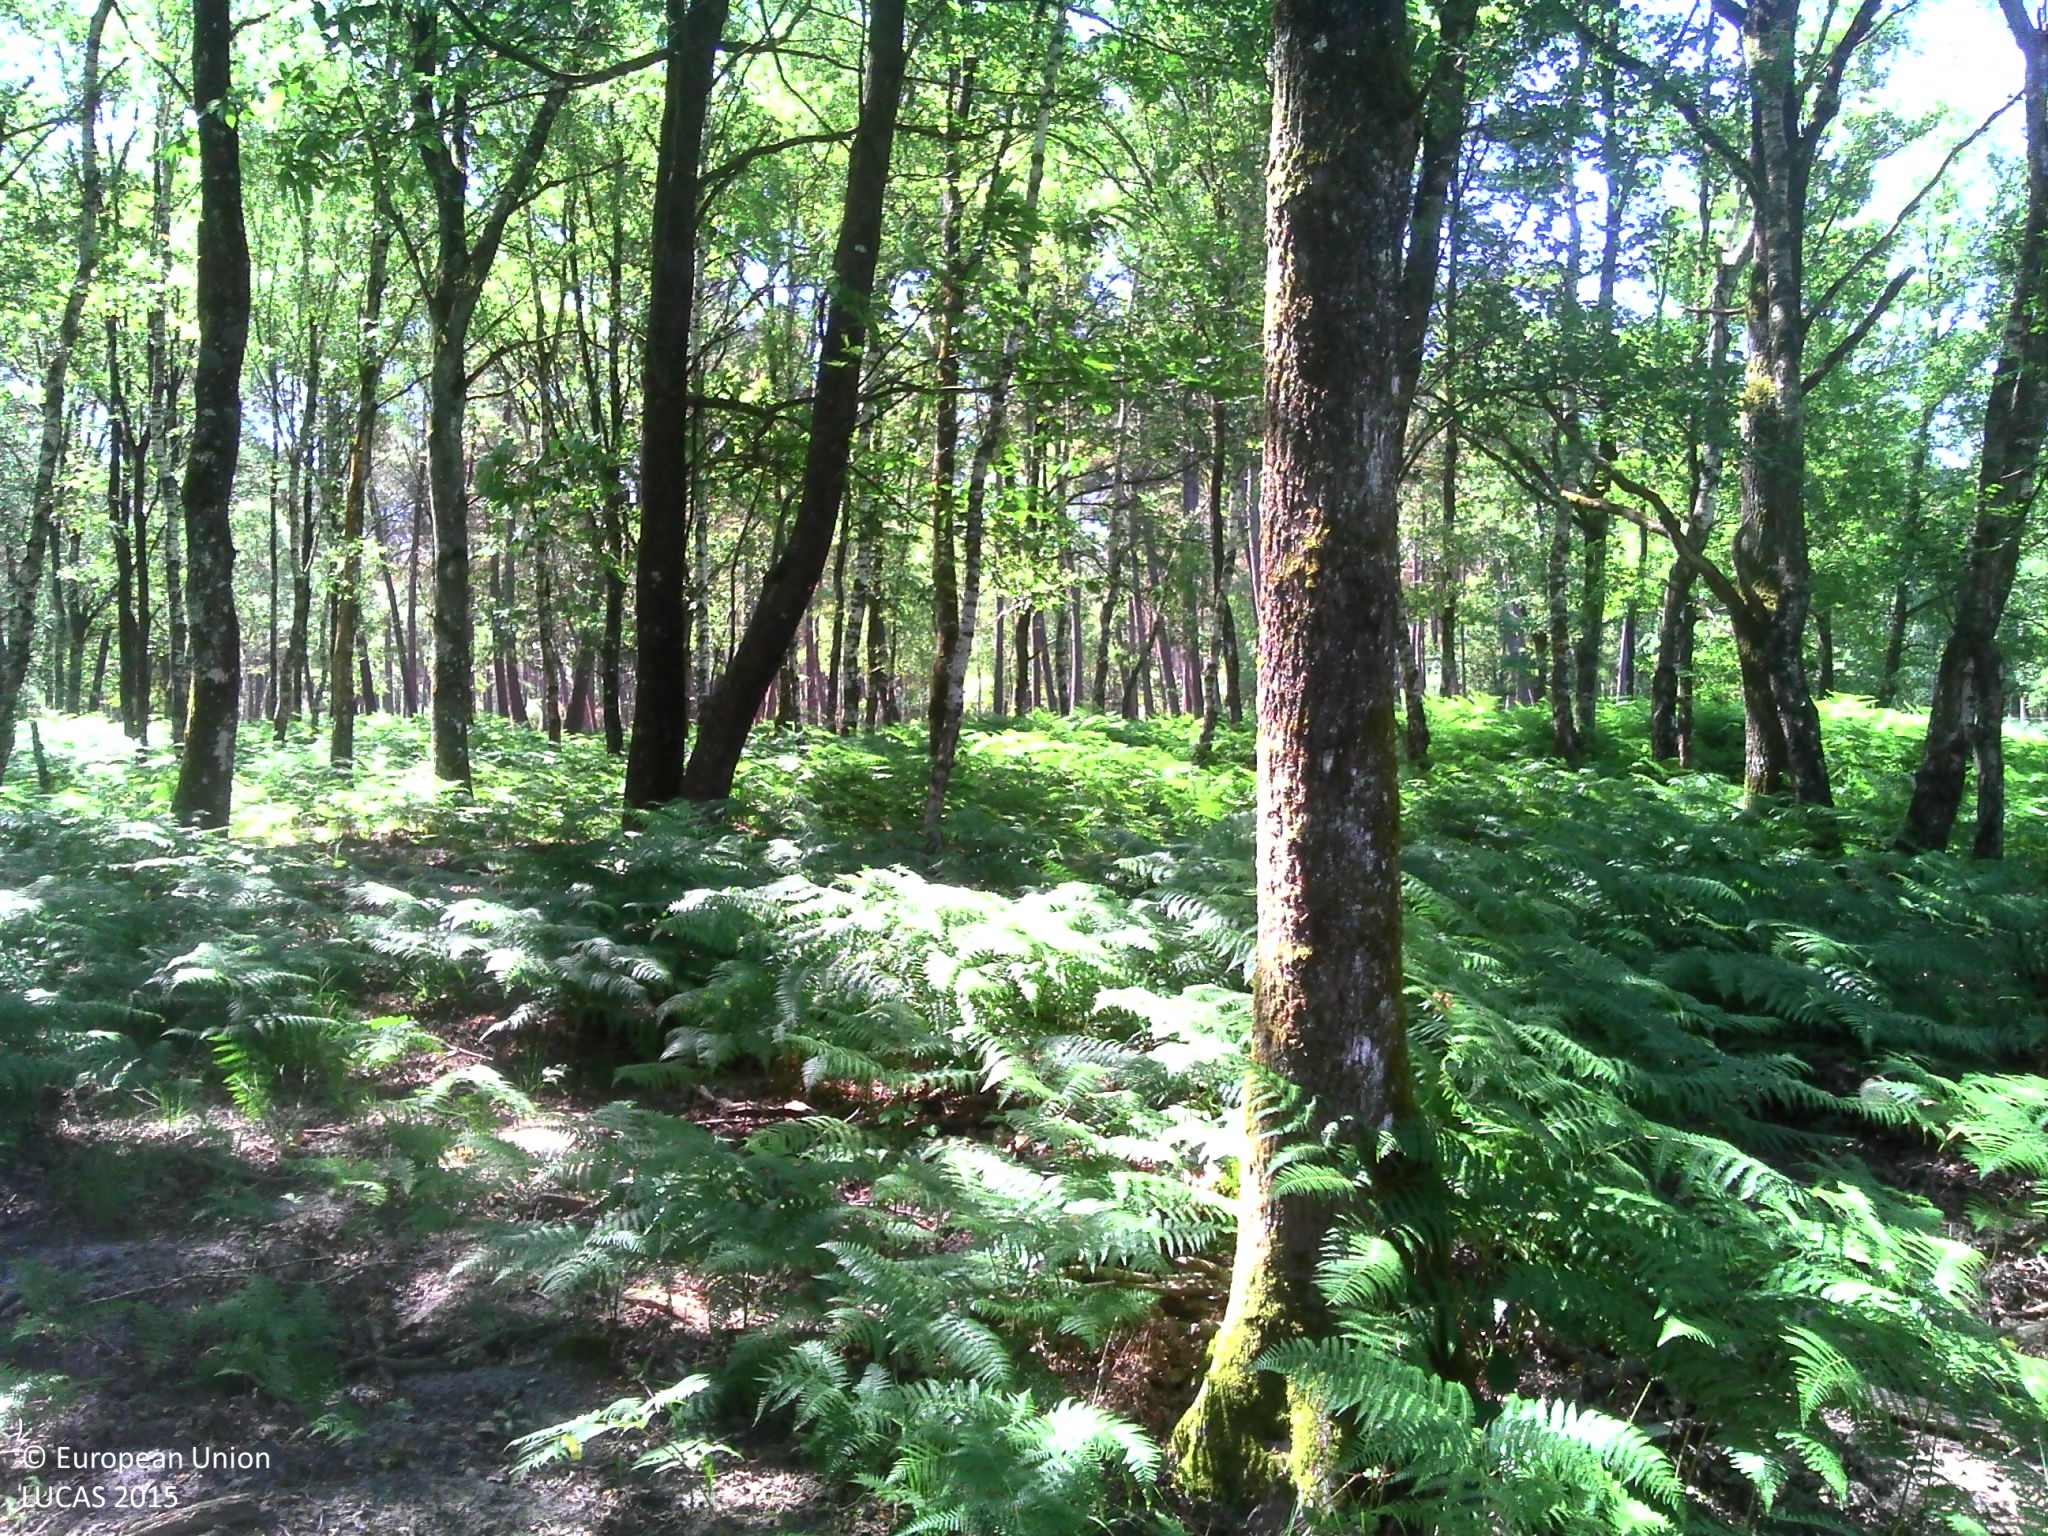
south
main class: Woodland
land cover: Broadleaved woodland
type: mesophytic deciduous forest
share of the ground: > 75 %
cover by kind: broadleaved forest trees 70 %, herbaceous plants 20 %, shrubs 5 %, lichens and mosses 5 %
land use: Forestry
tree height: > 5 m
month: June
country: FR
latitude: 47.3621
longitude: 0.3251
